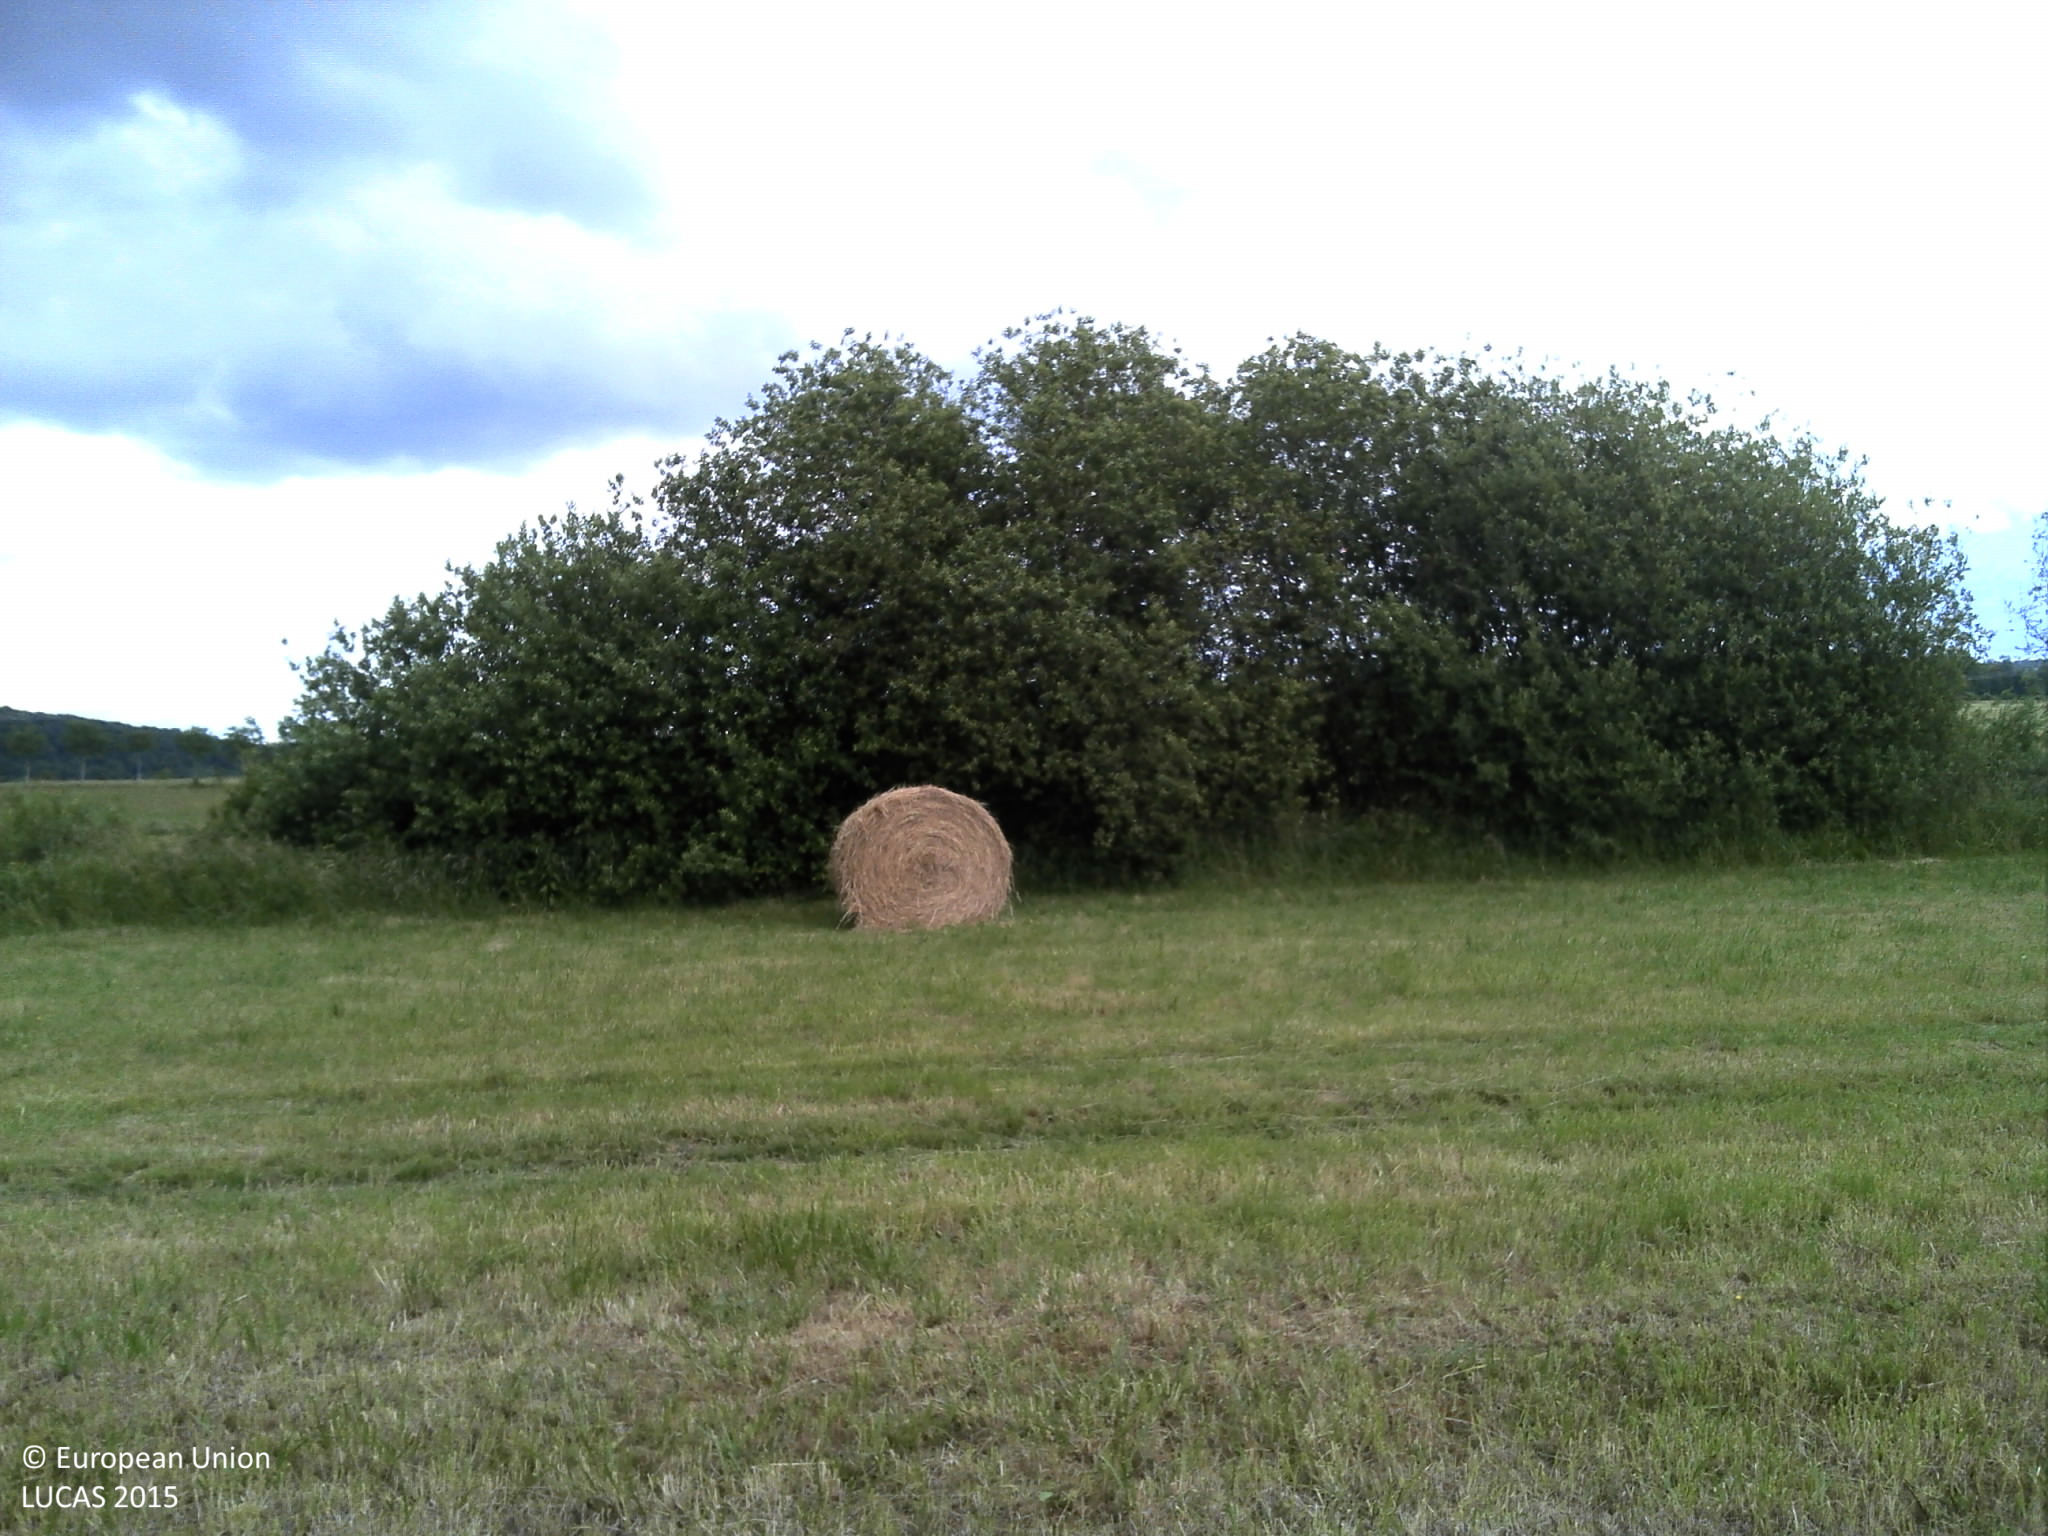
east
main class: Grassland
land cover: Grassland without tree/shrub cover
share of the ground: > 75 %
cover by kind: herbaceous plants 100 %
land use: Agriculture (excluding fallow land and kitchen gardens)
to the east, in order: Grassland without tree/shrub cover; Abandoned hedges; Inland fresh running water; Shrubland with sparse tree cover; Fences; Grassland without tree/shrub cover; Fences; Grass margins; Fences; Maize
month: June
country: FR
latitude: 49.6346
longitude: 4.8325
